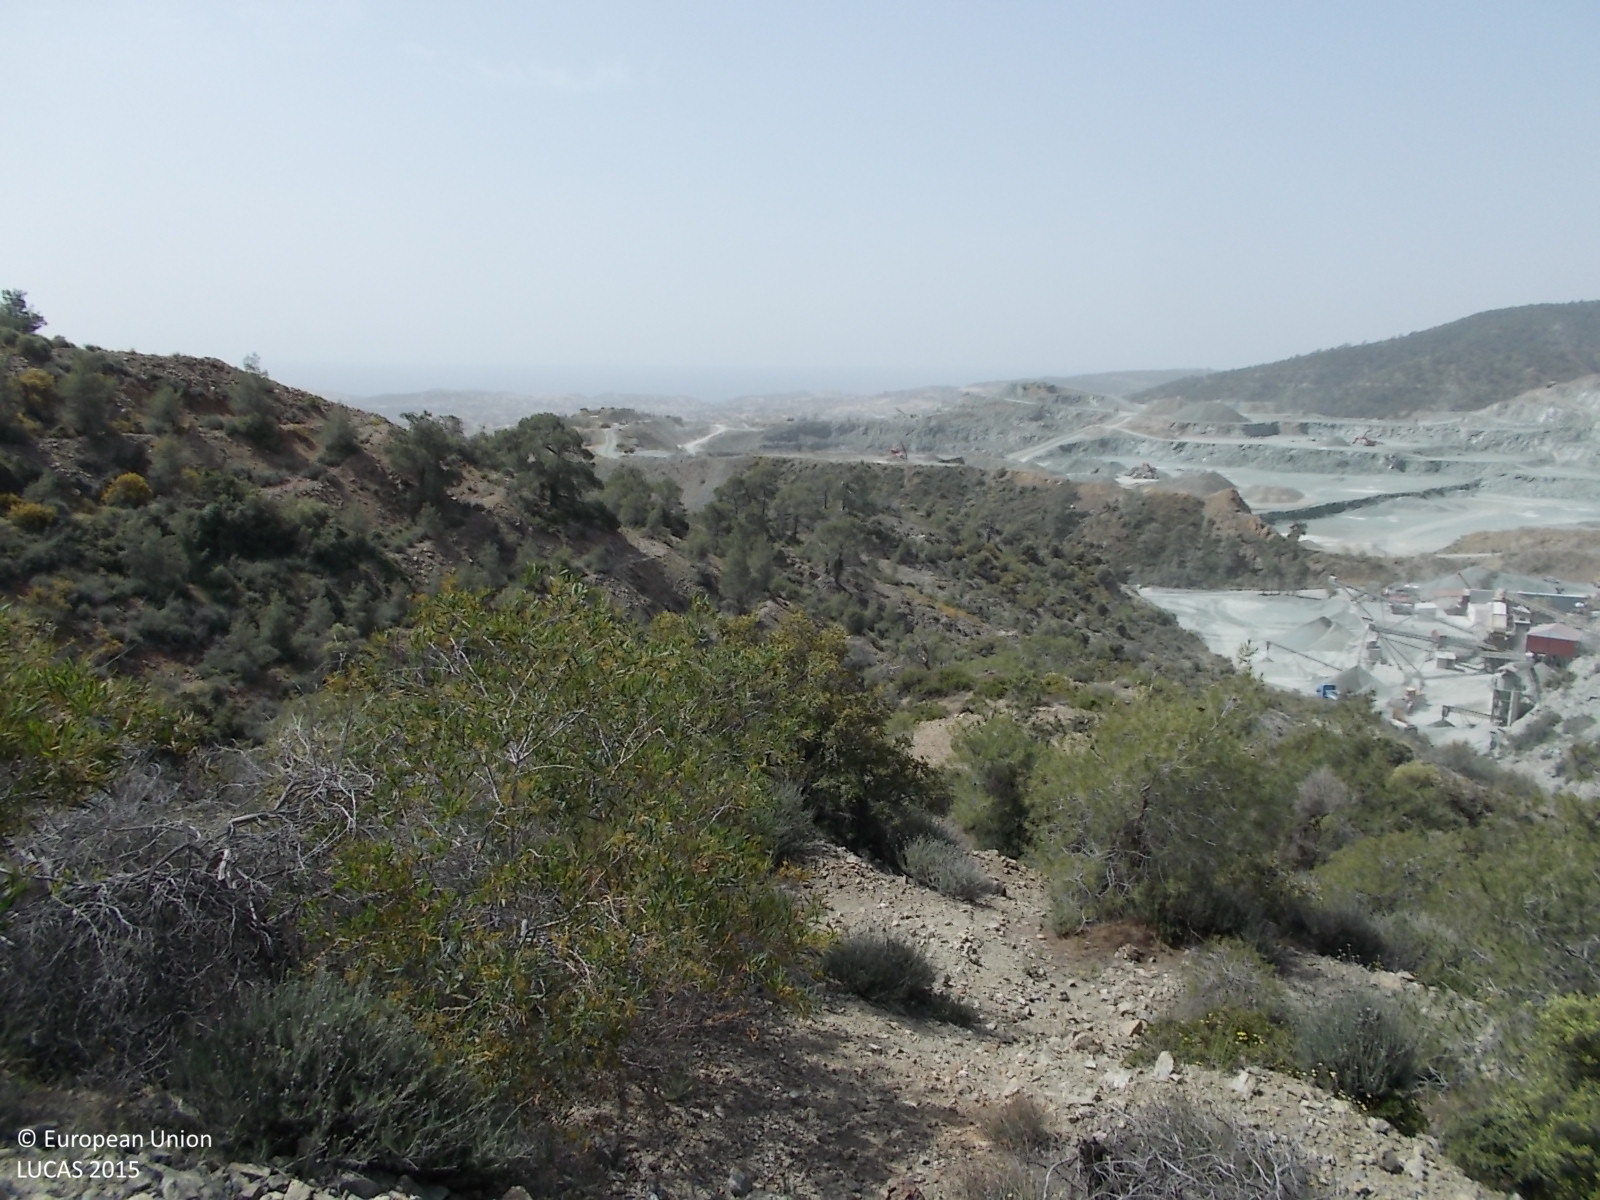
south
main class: Shrubland
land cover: Shrubland with sparse tree cover
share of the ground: > 75 %
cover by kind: shrubs 95 %, coniferous forest trees 5 %
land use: Semi-natural and natural areas not in use
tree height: > 5 m
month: April
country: CY
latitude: 34.7912
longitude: 33.1568
